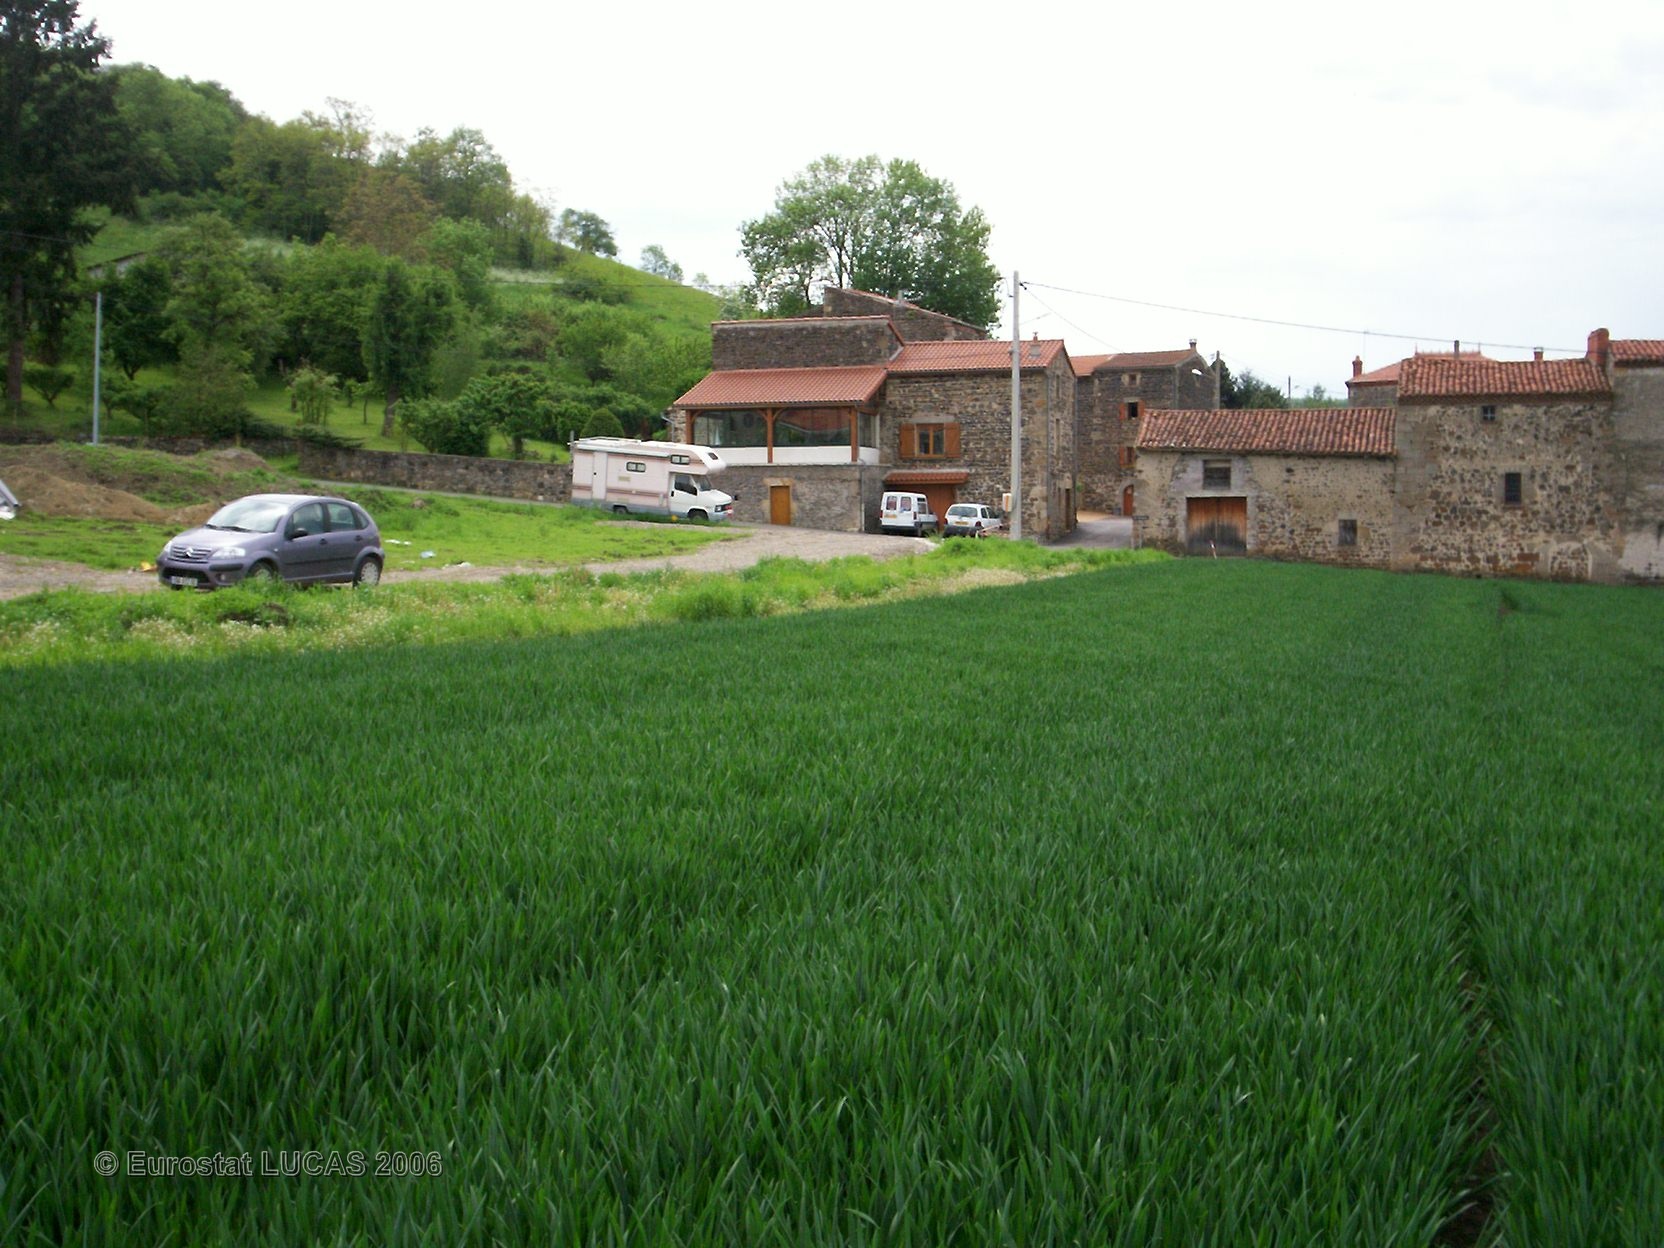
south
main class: Cropland
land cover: Common wheat
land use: Agriculture (excluding fallow land and kitchen gardens)
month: May
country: FR
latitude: 45.5986
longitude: 3.2961
